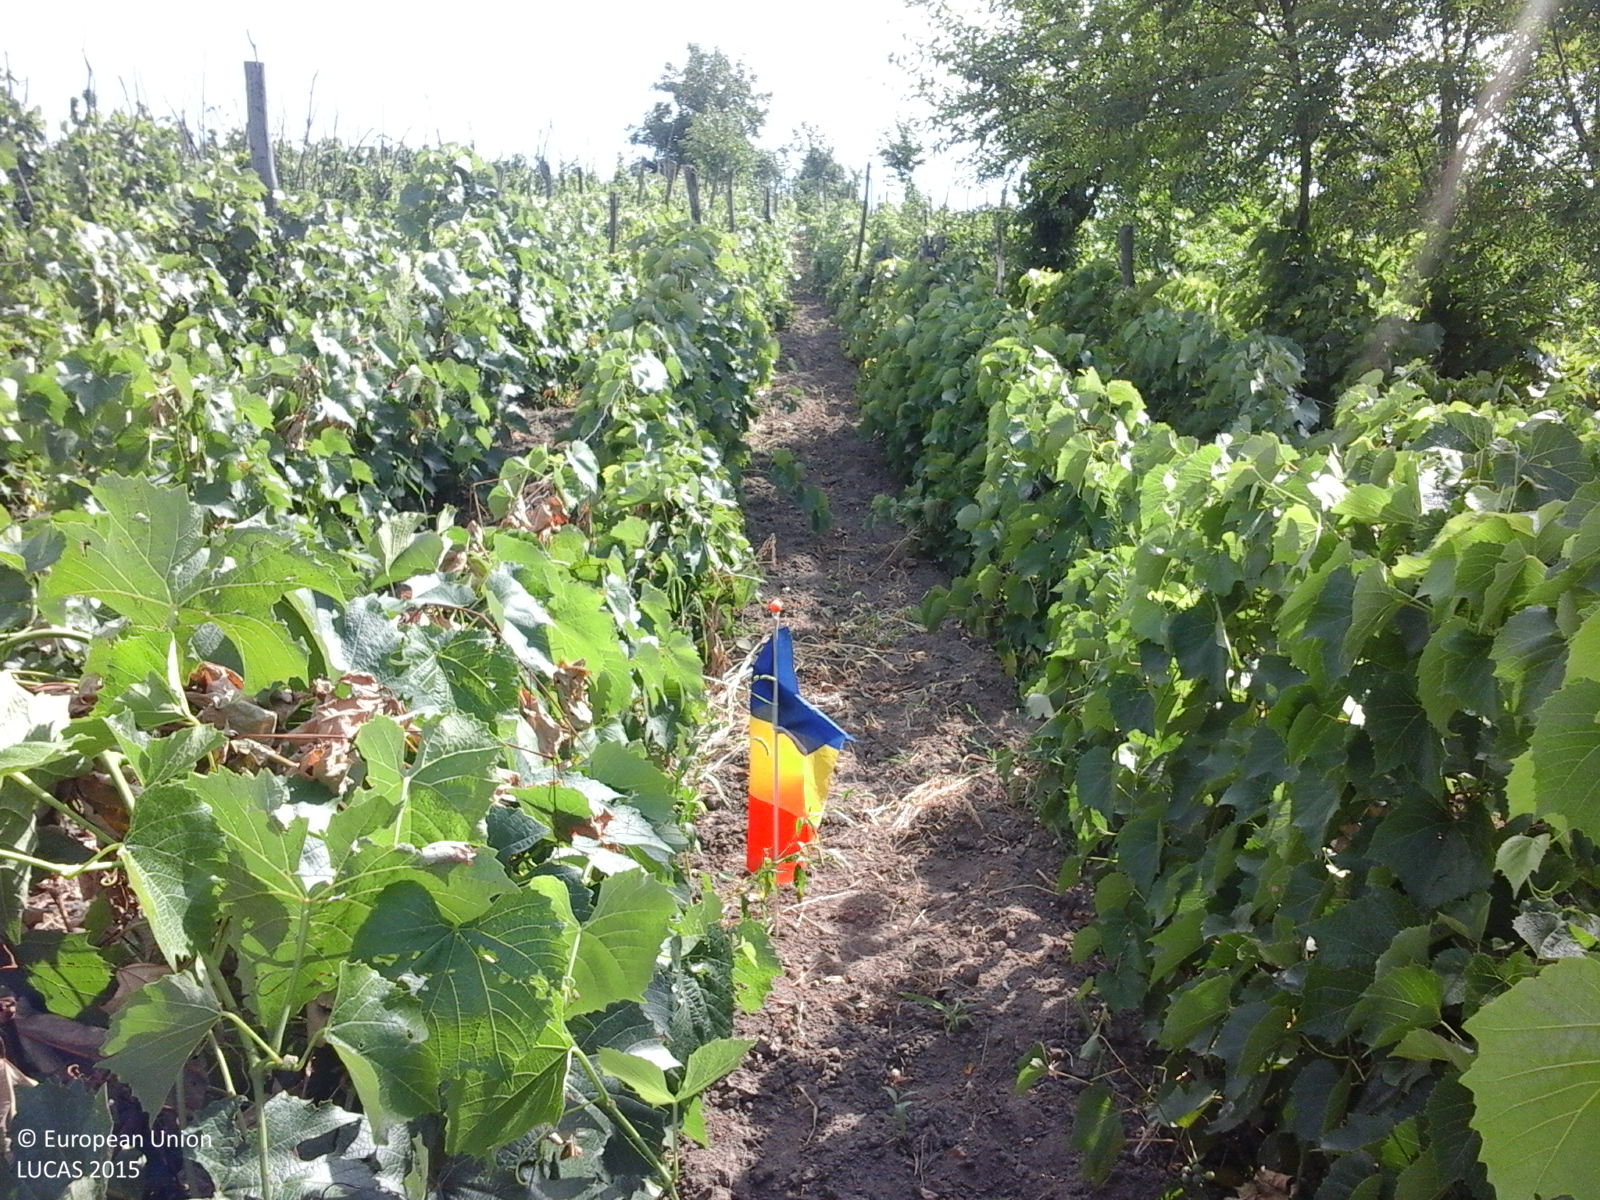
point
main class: Cropland
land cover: Vineyards
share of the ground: > 75 %
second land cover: Grassland without tree/shrub cover
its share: > 75 %
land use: Agriculture (excluding fallow land and kitchen gardens)
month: July
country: RO
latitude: 46.0475
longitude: 27.6488
